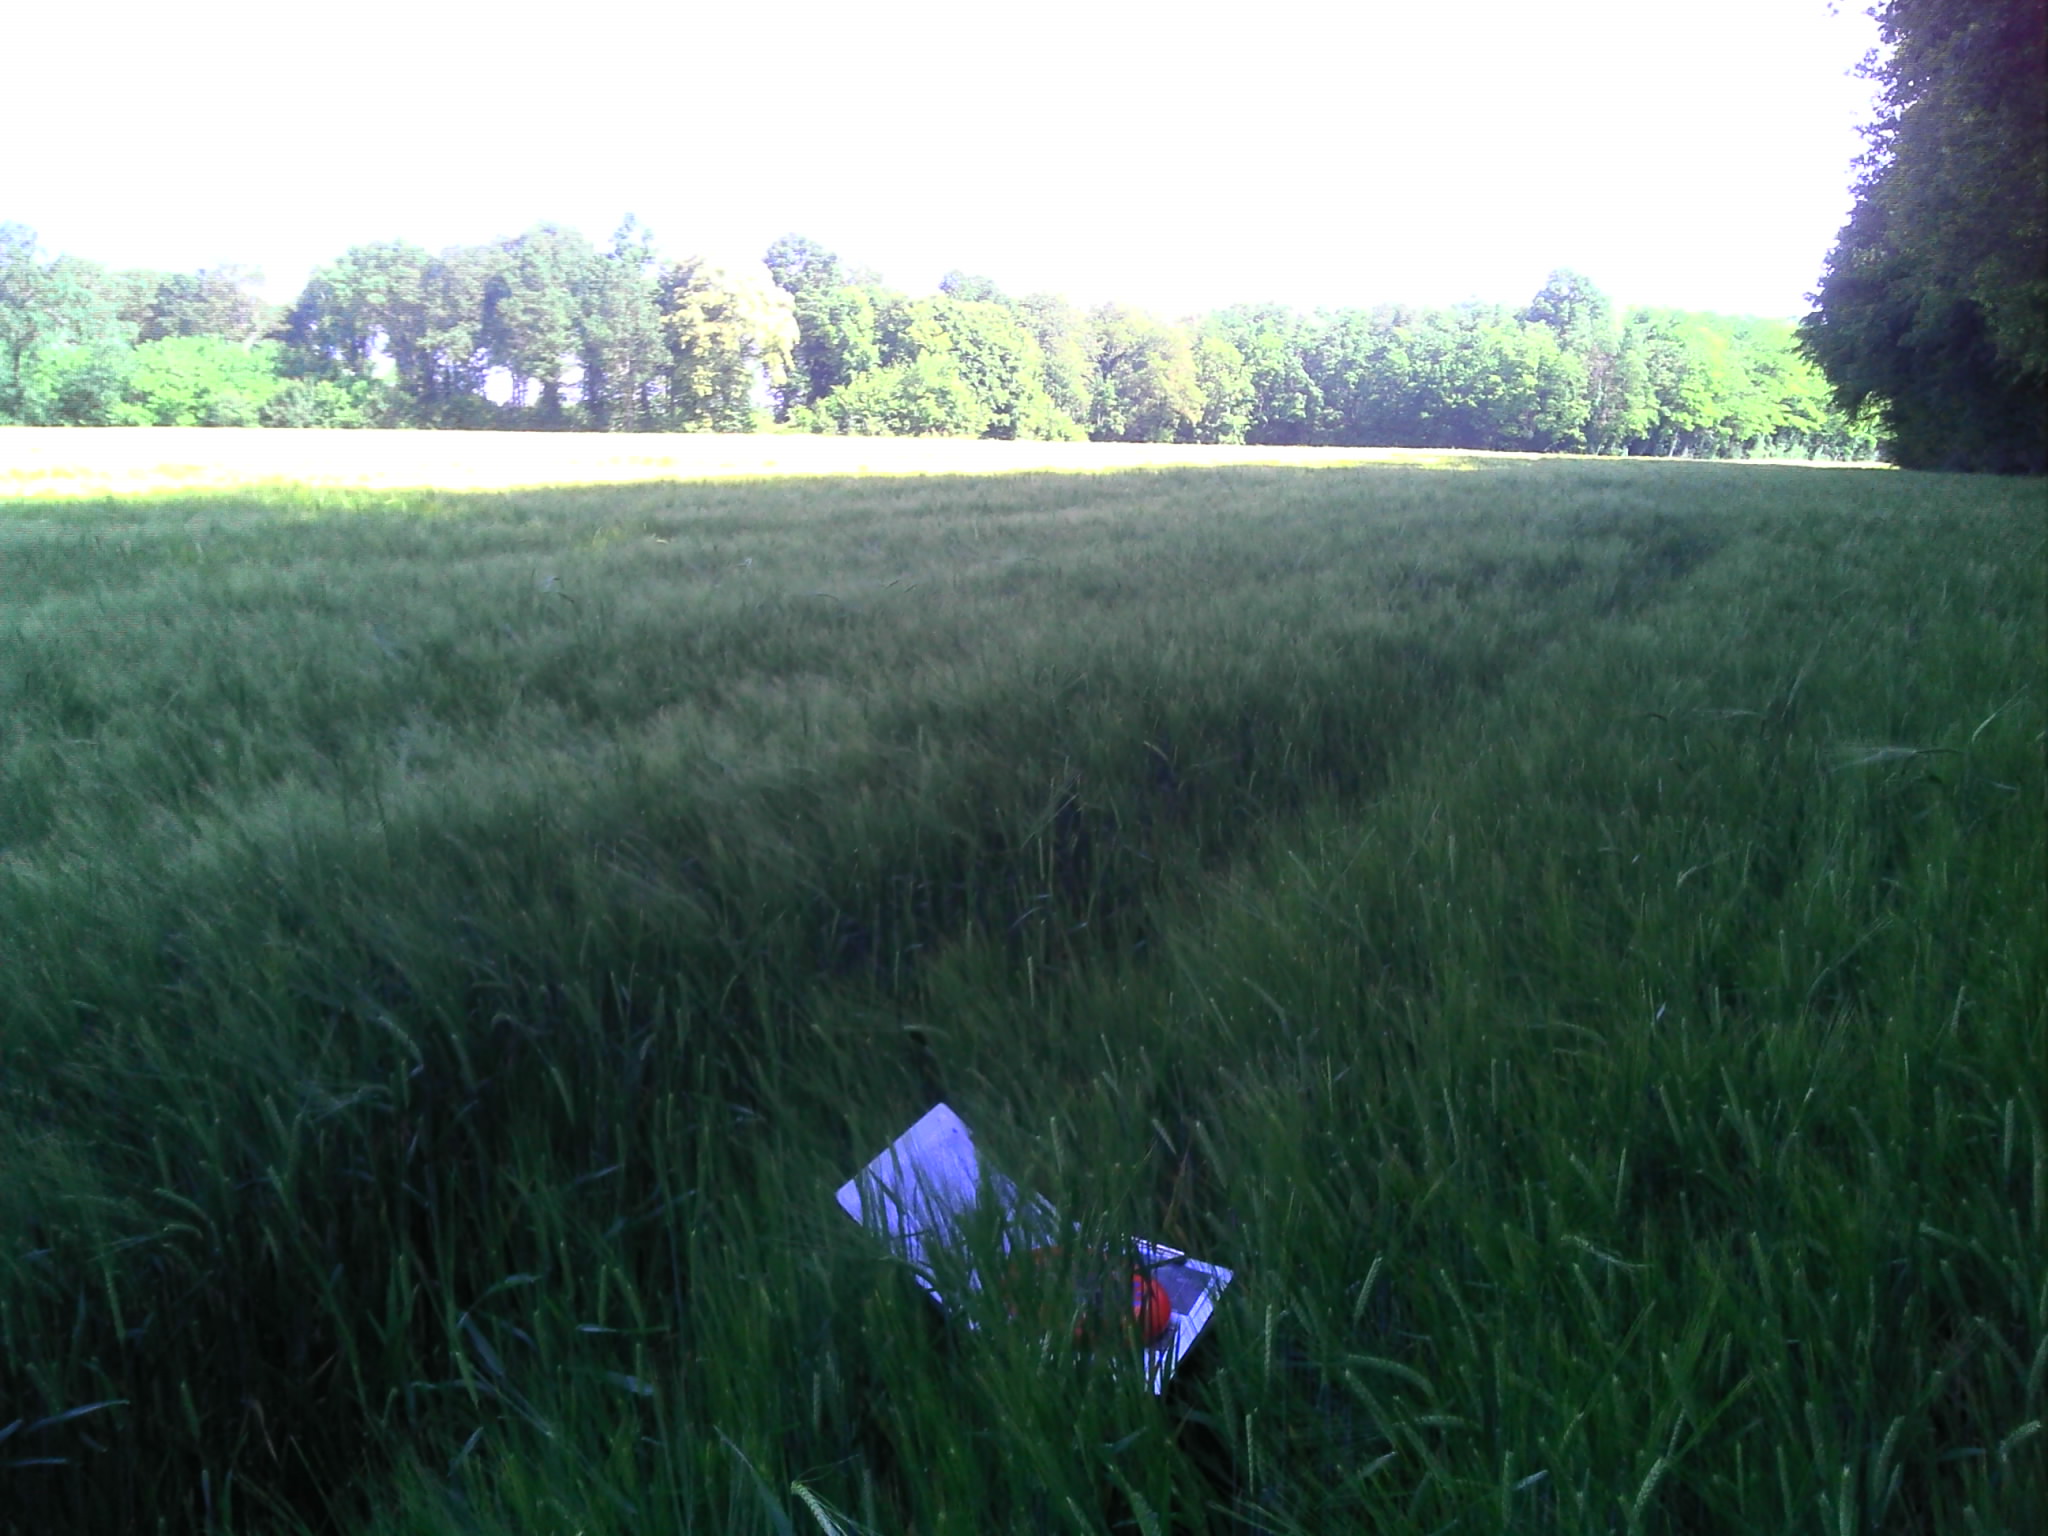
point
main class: Cropland
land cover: Barley
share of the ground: > 75 %
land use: Agriculture (excluding fallow land and kitchen gardens)
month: May
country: FR
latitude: 46.6157
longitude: 5.0530
